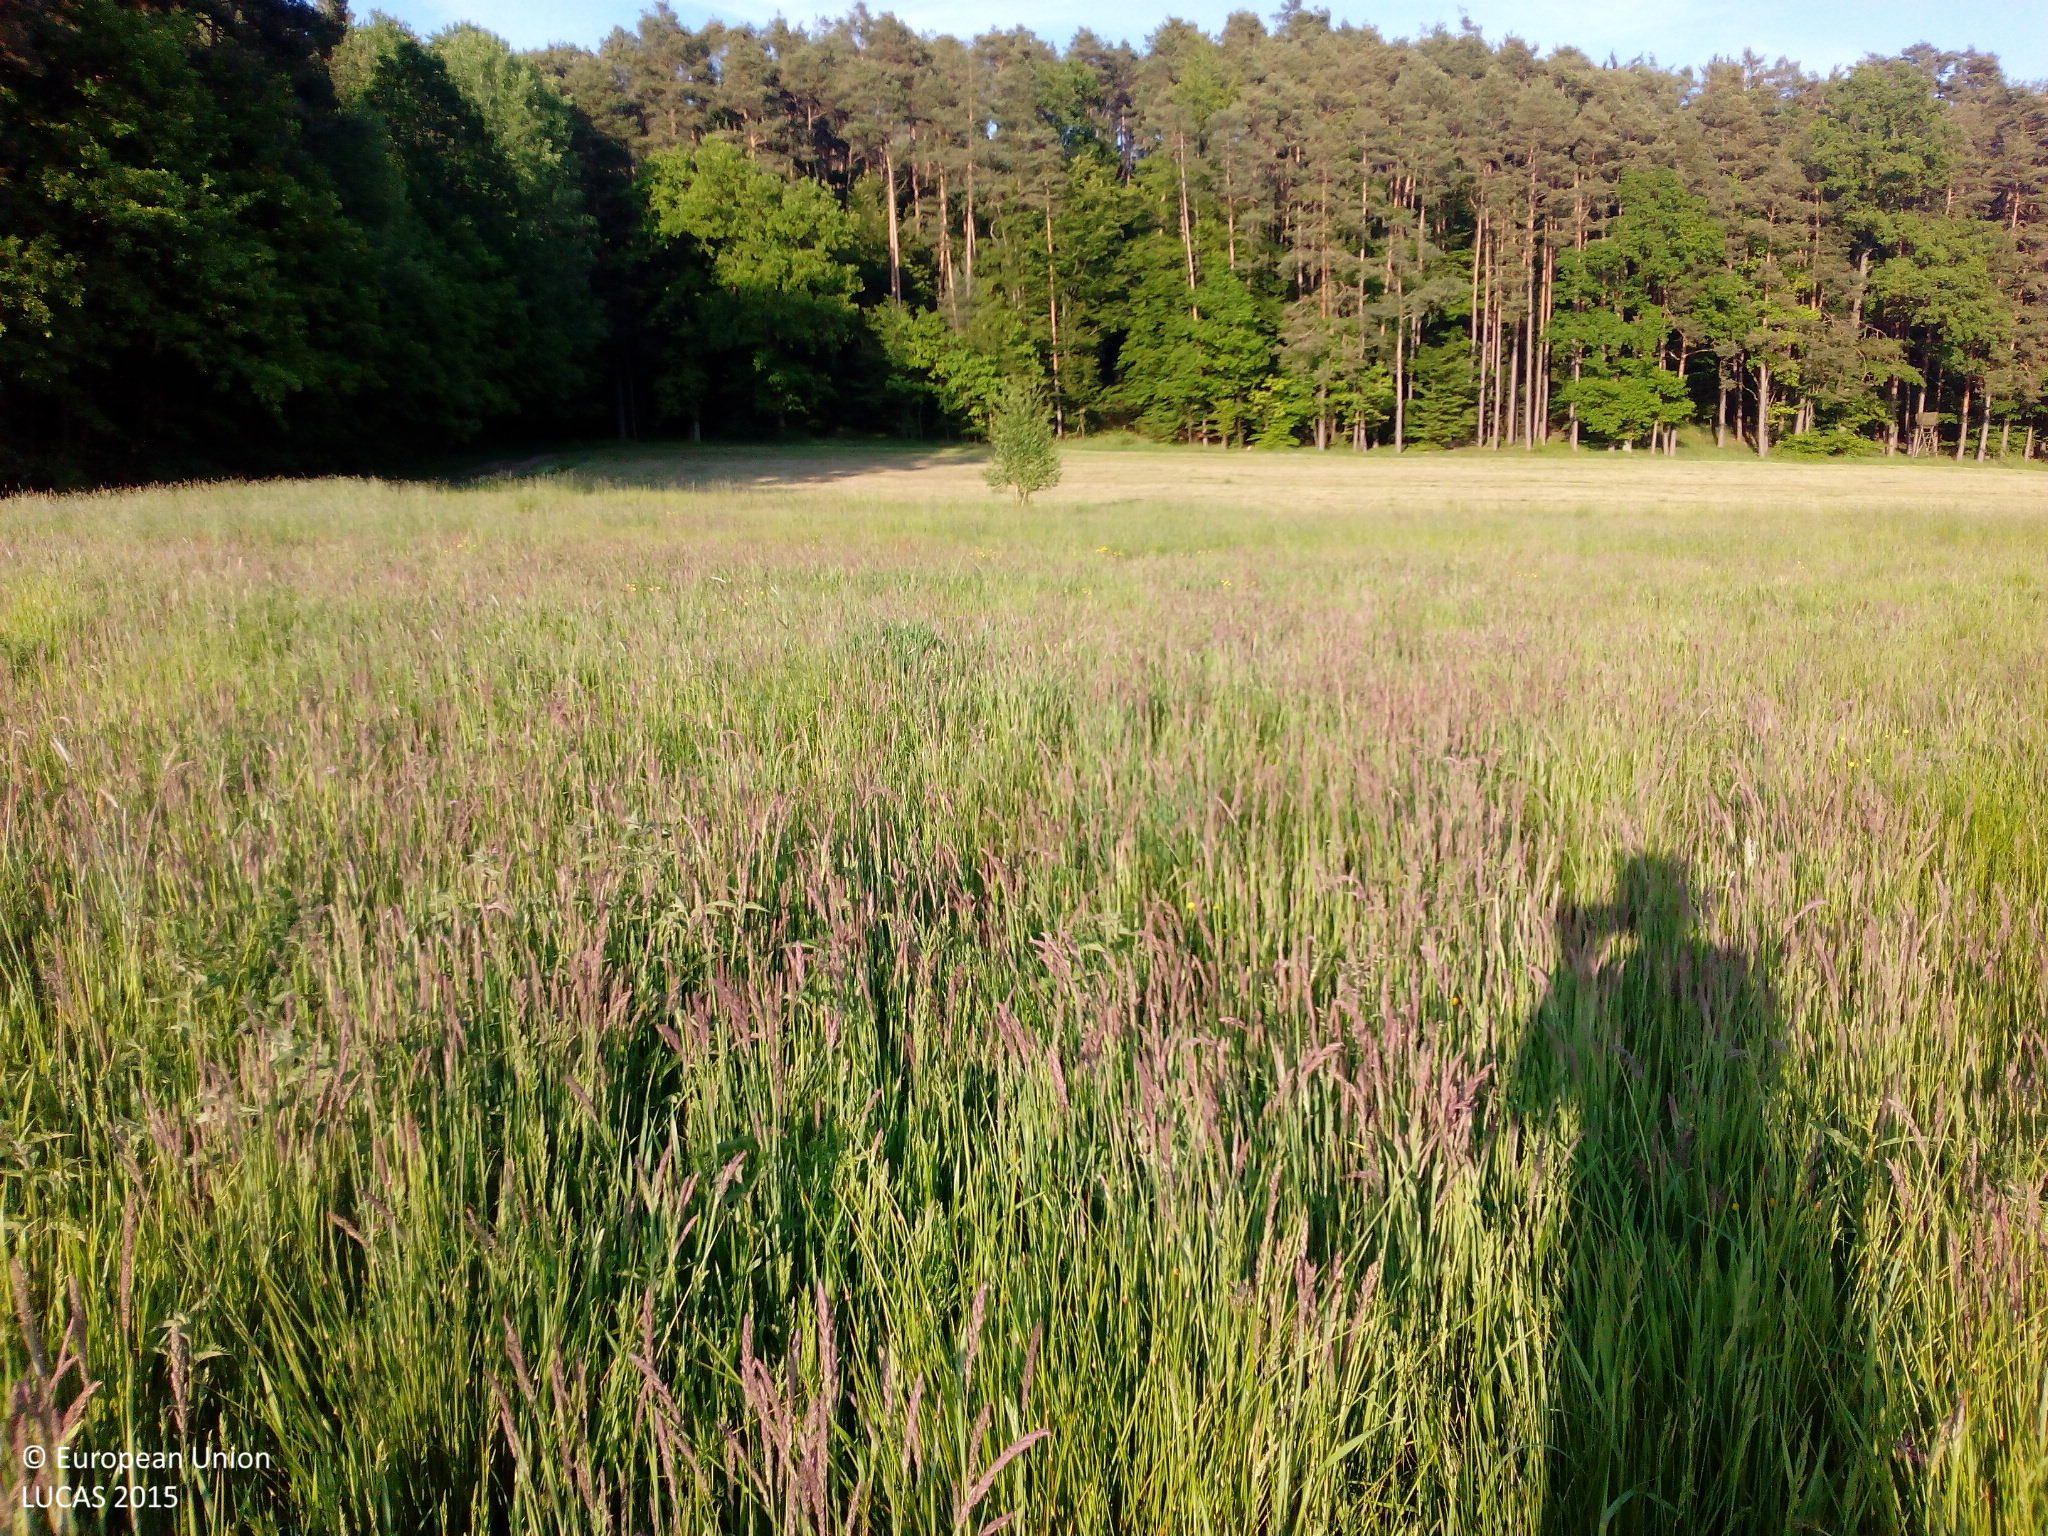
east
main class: Grassland
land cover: Grassland without tree/shrub cover
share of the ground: > 75 %
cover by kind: herbaceous plants 95 %, unconsolidated bare surface 5 %
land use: Agriculture (excluding fallow land and kitchen gardens)
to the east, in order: Grassland without tree/shrub cover; Tracks; Pine dominated mixed woodland; Other coniferous woodland
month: May
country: DE
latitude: 49.2214
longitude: 11.4686
